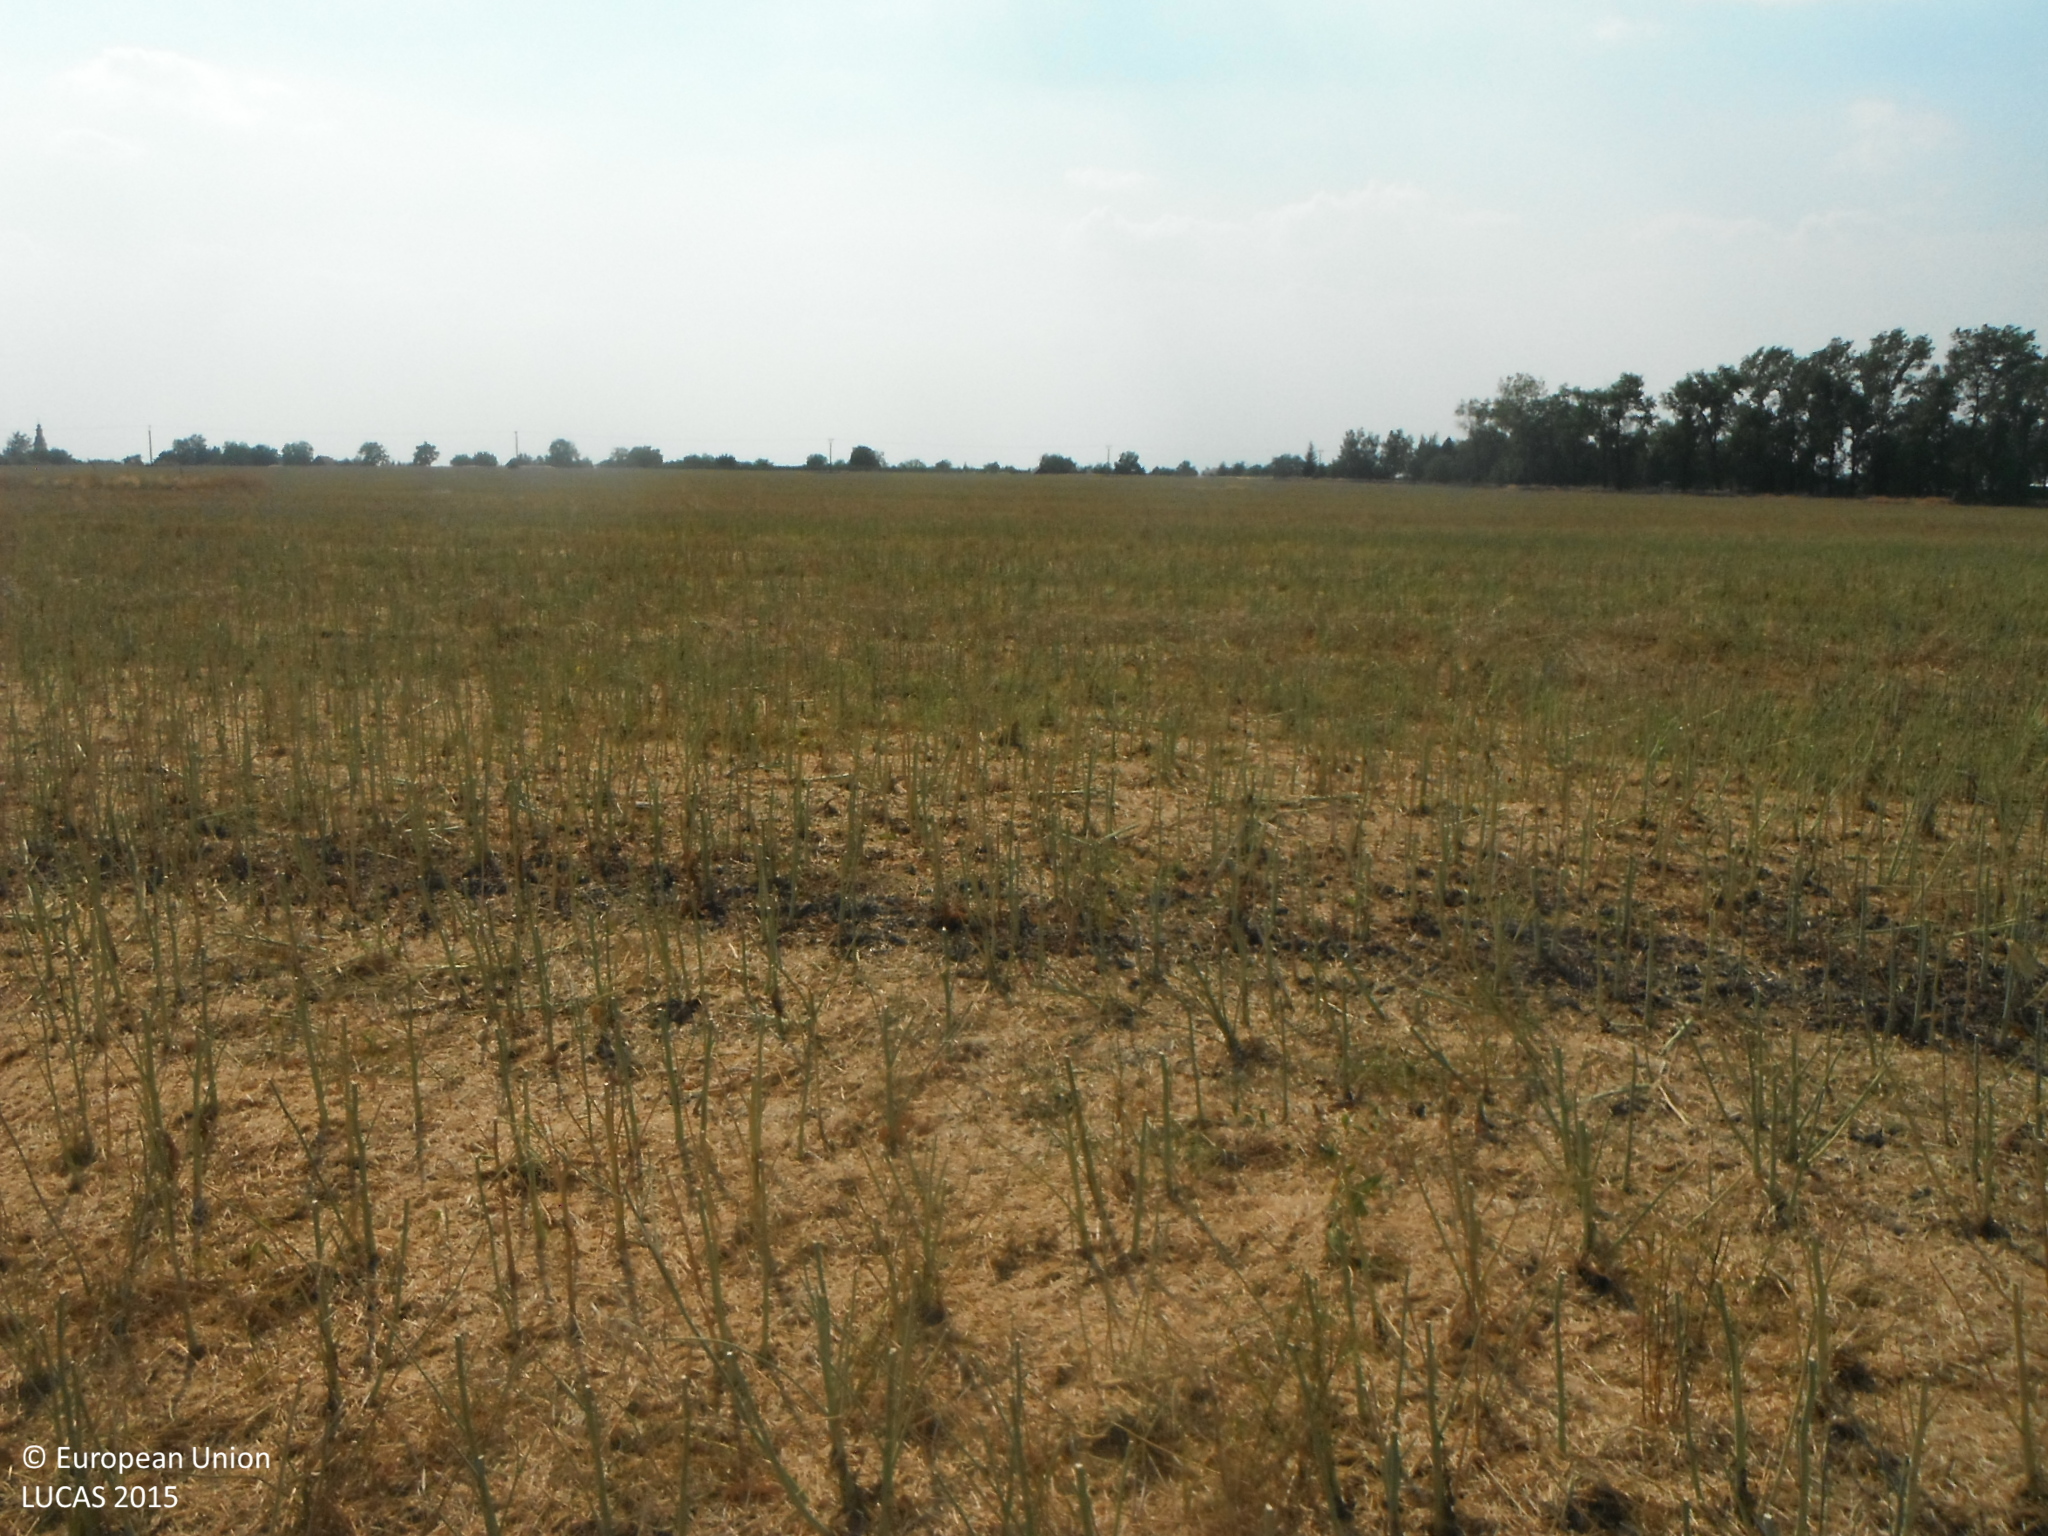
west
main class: Cropland
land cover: Rape and turnip rape
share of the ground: > 75 %
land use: Agriculture (excluding fallow land and kitchen gardens)
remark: Harvested field
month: July
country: SK
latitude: 48.7378
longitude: 22.0899
